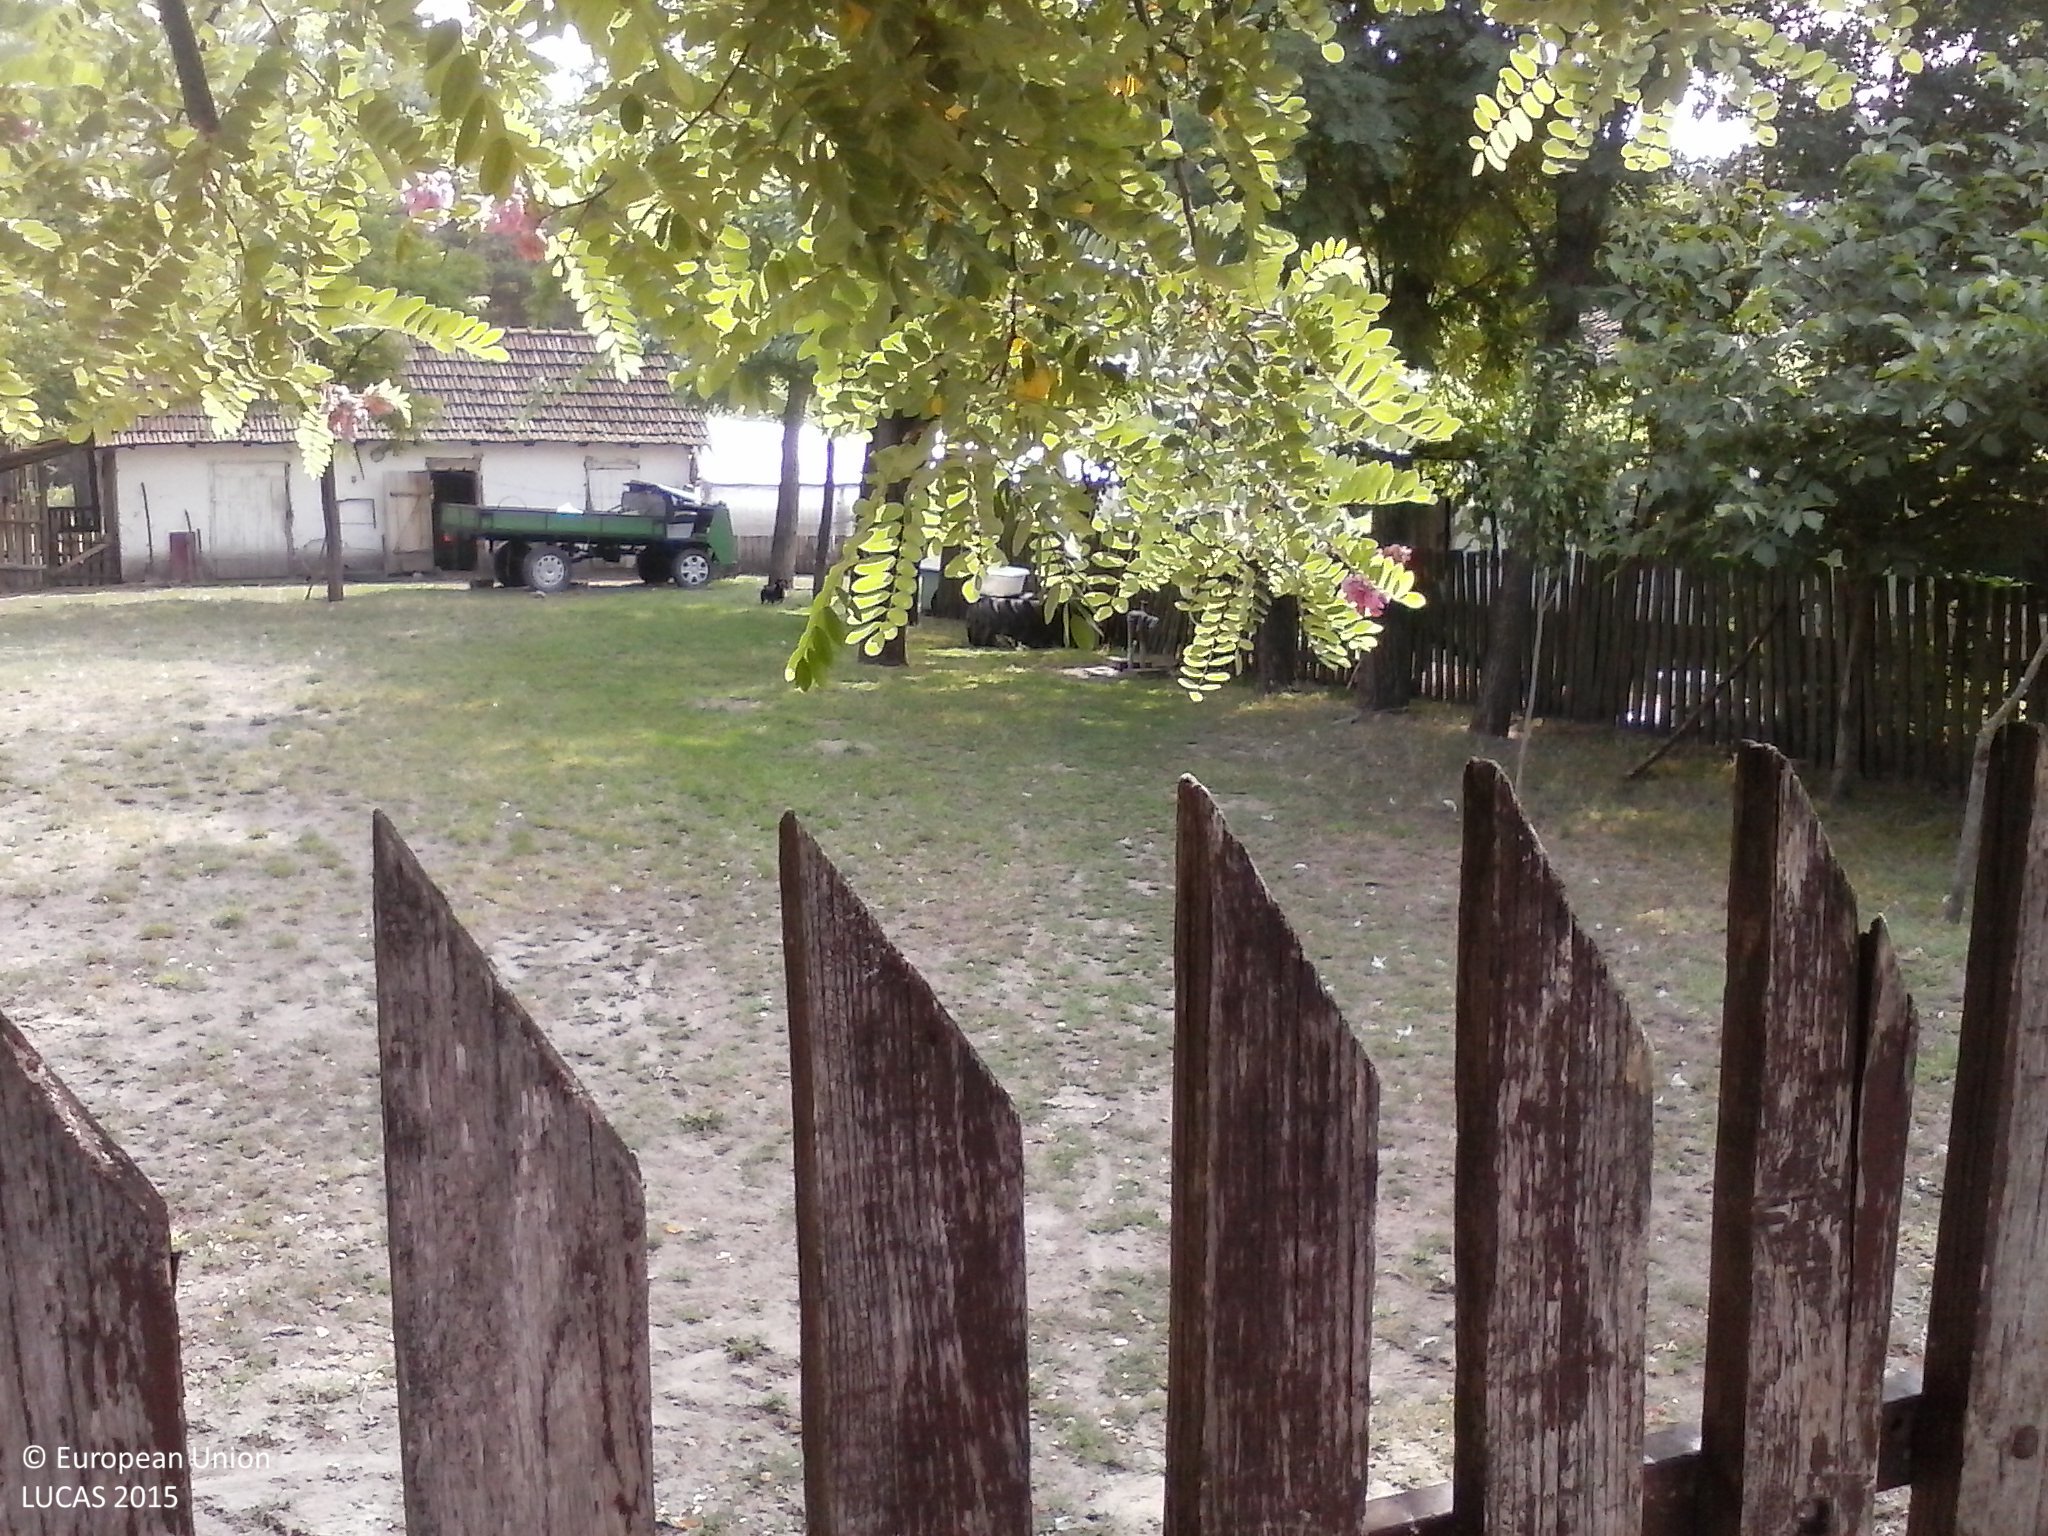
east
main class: Artificial land
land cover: Non built-up area features
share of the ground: > 75 %
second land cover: Spontaneously vegetated surfaces
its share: > 75 %
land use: Residential
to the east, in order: Artificial constructions in urban areas; Spontaneously vegetated surfaces; Spruce dominated coniferous woodland; Tracks; Broadleaved woodland
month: June
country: HU
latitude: 46.2401
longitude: 19.6532
